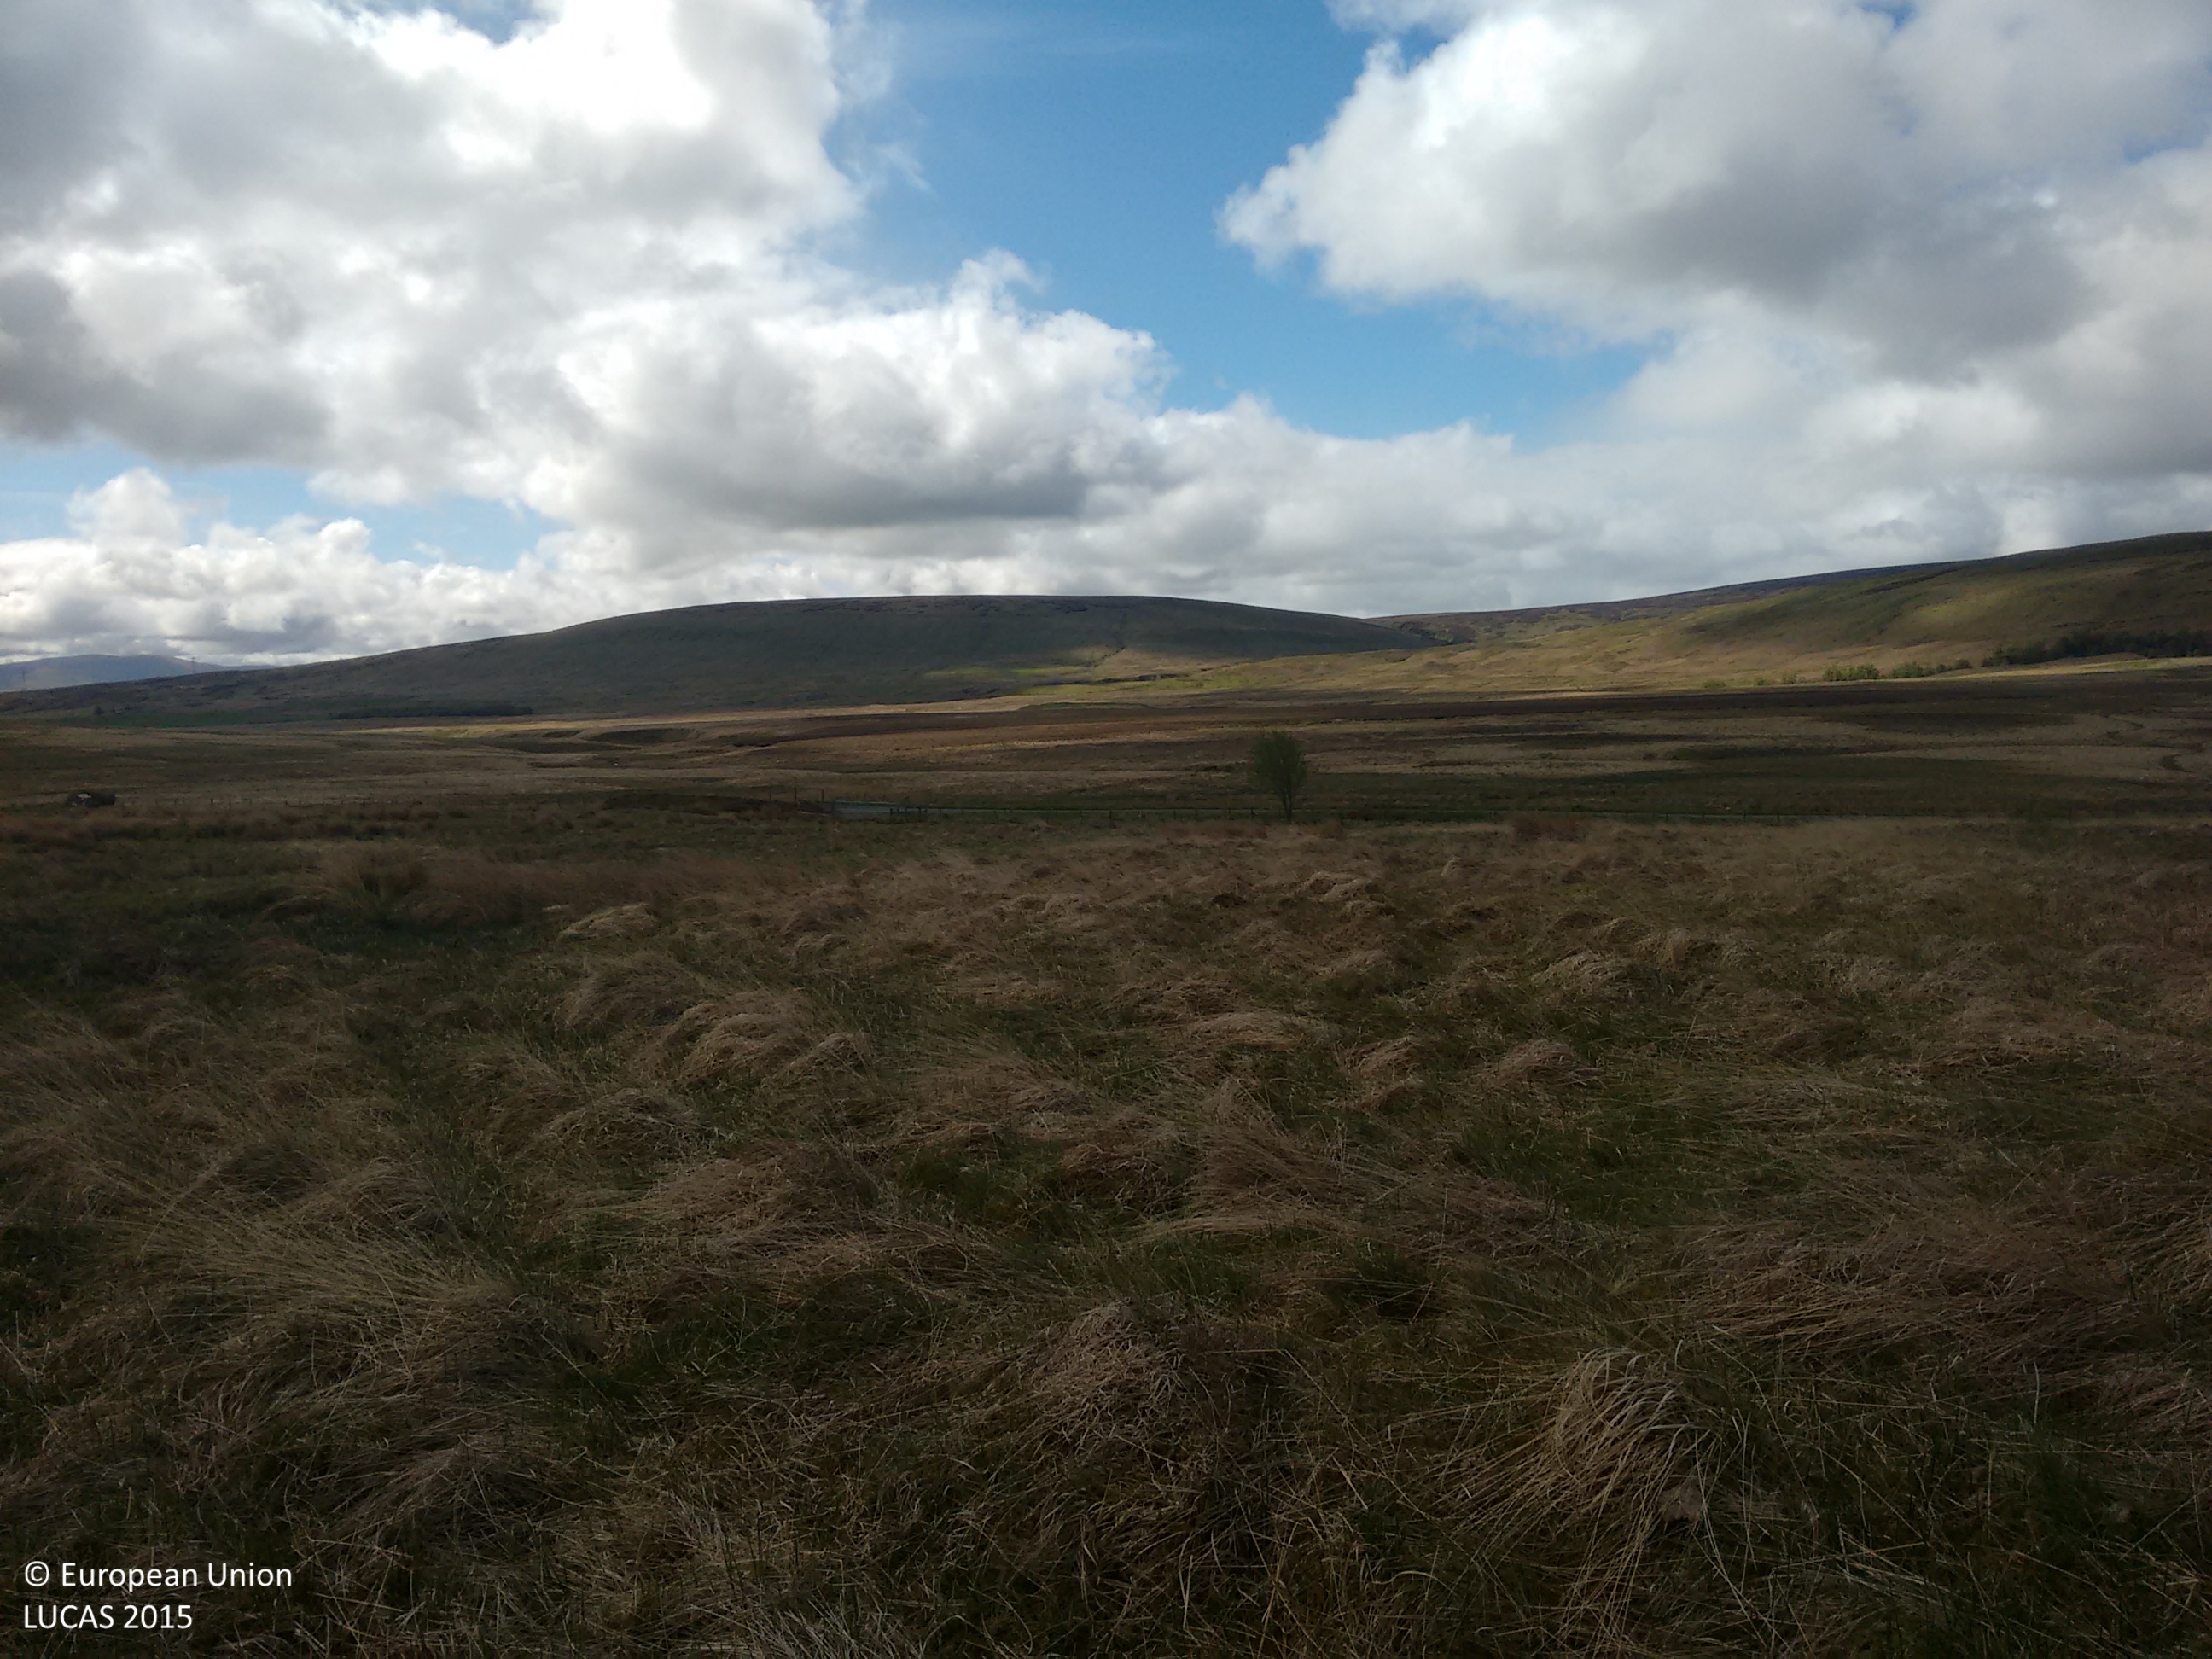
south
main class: Grassland
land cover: Grassland without tree/shrub cover
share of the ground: > 75 %
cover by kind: herbaceous plants 80 %, lichens and mosses 20 %
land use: Agriculture (excluding fallow land and kitchen gardens)
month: May
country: GB
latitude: 56.3139
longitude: -3.9721
